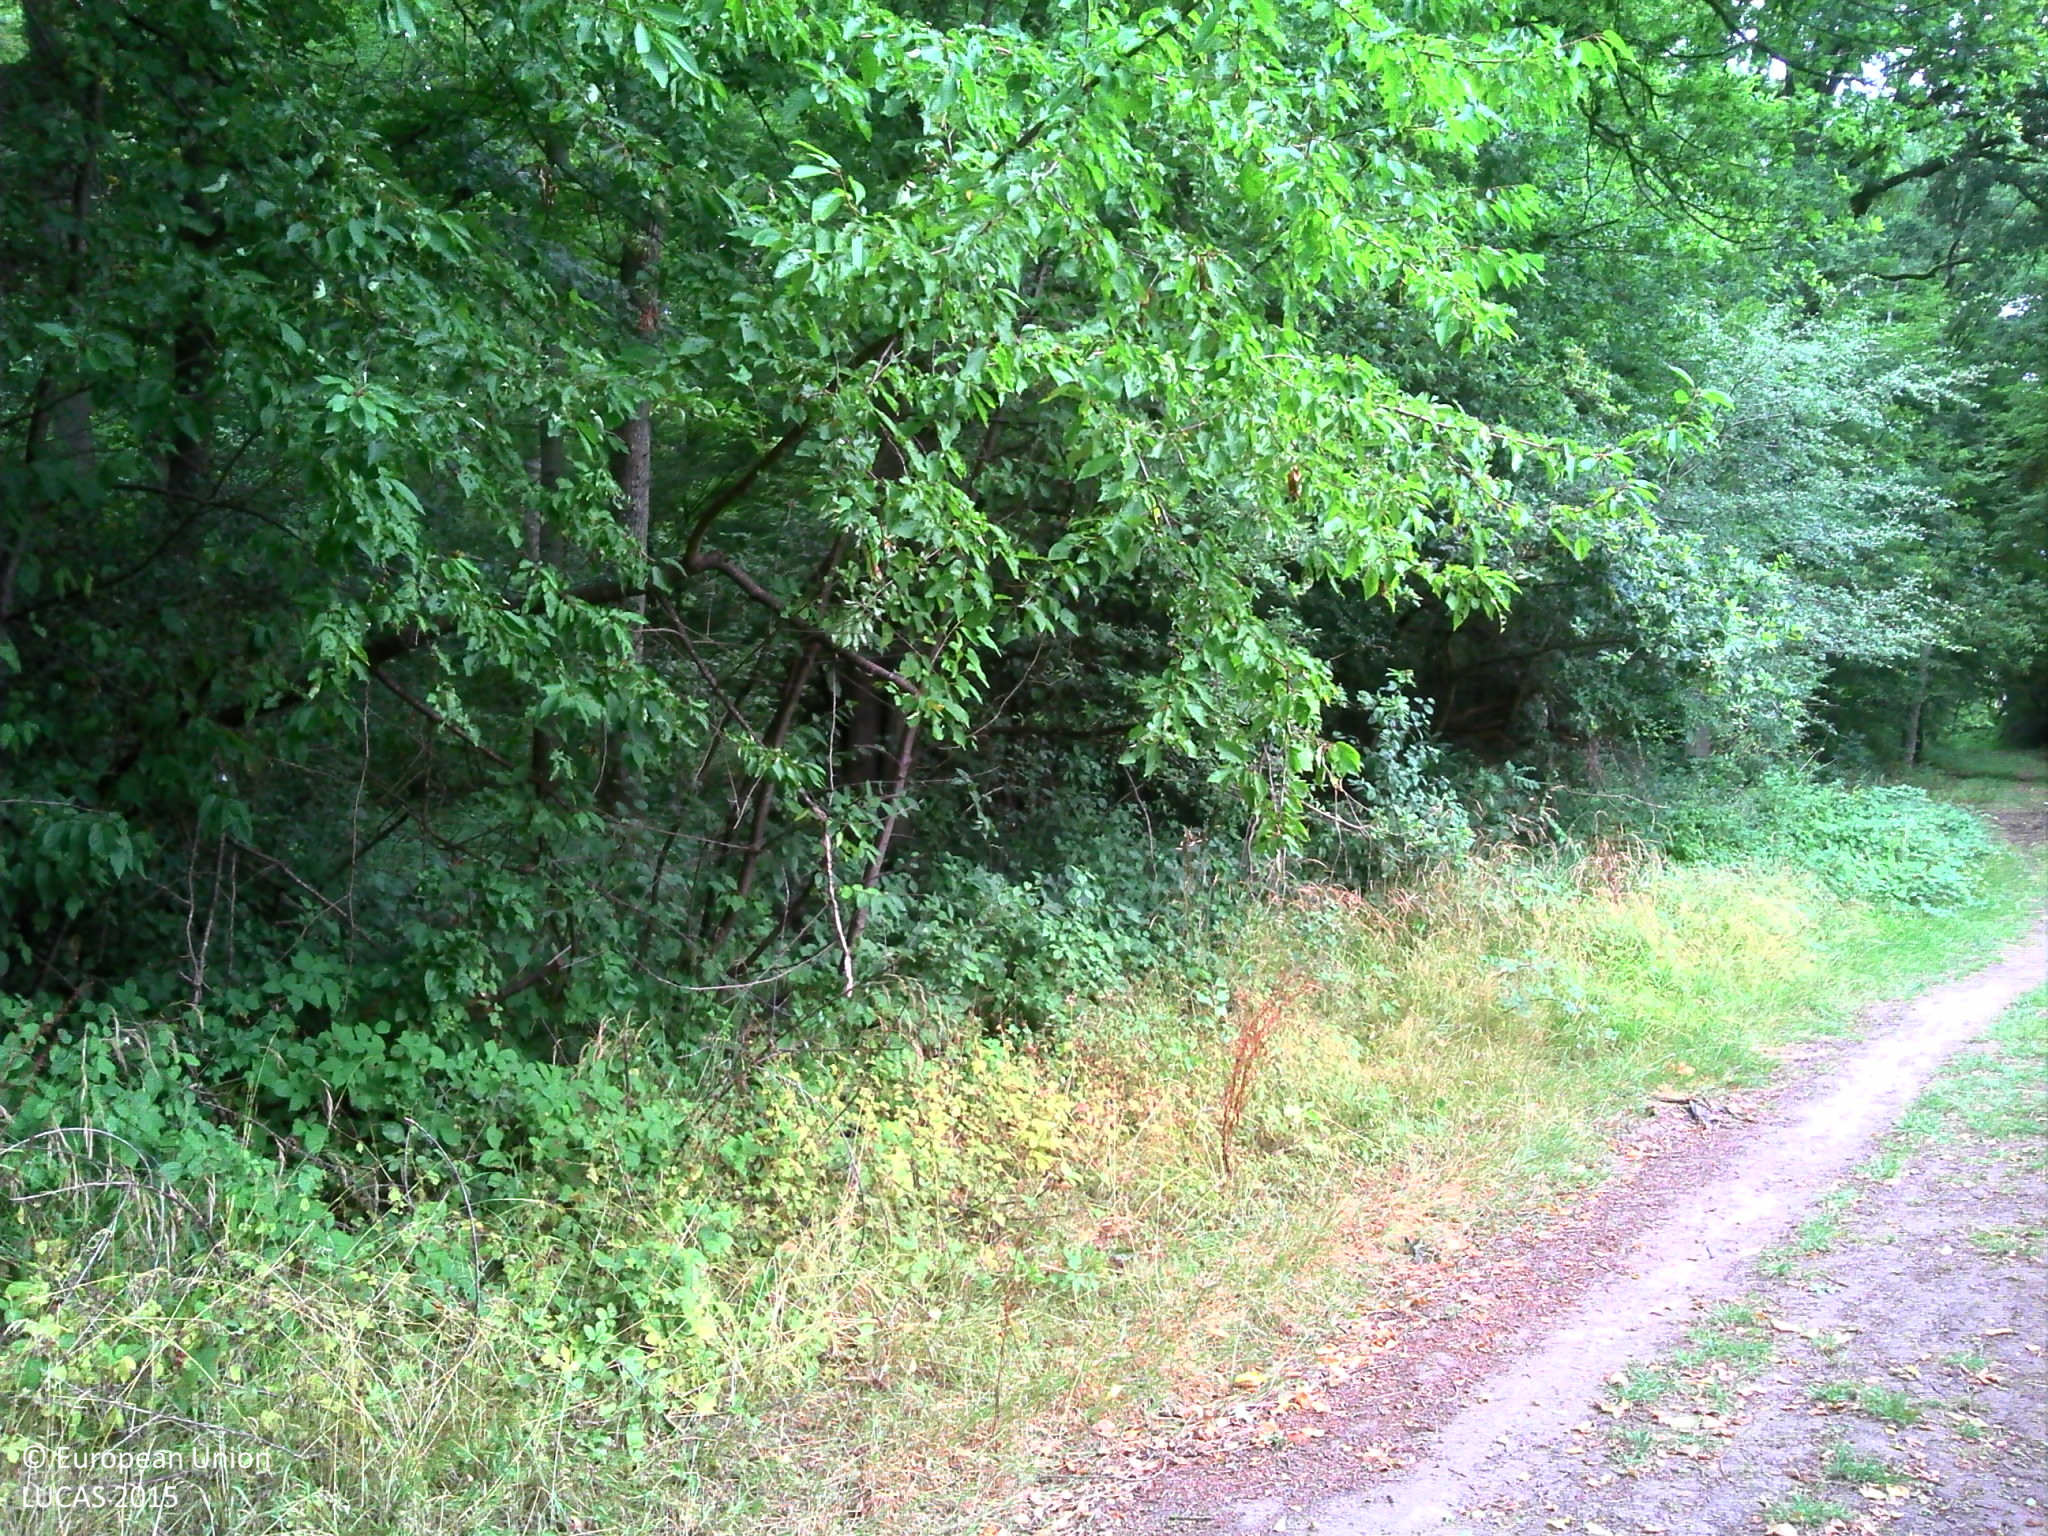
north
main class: Grassland
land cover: Grassland with sparse tree/shrub cover
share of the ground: > 75 %
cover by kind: herbaceous plants 80 %, lichens and mosses 10 %, broadleaved forest trees 5 %, consolidated bare surface 5 %
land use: Residential
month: July
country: FR
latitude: 48.7572
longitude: 2.6852
